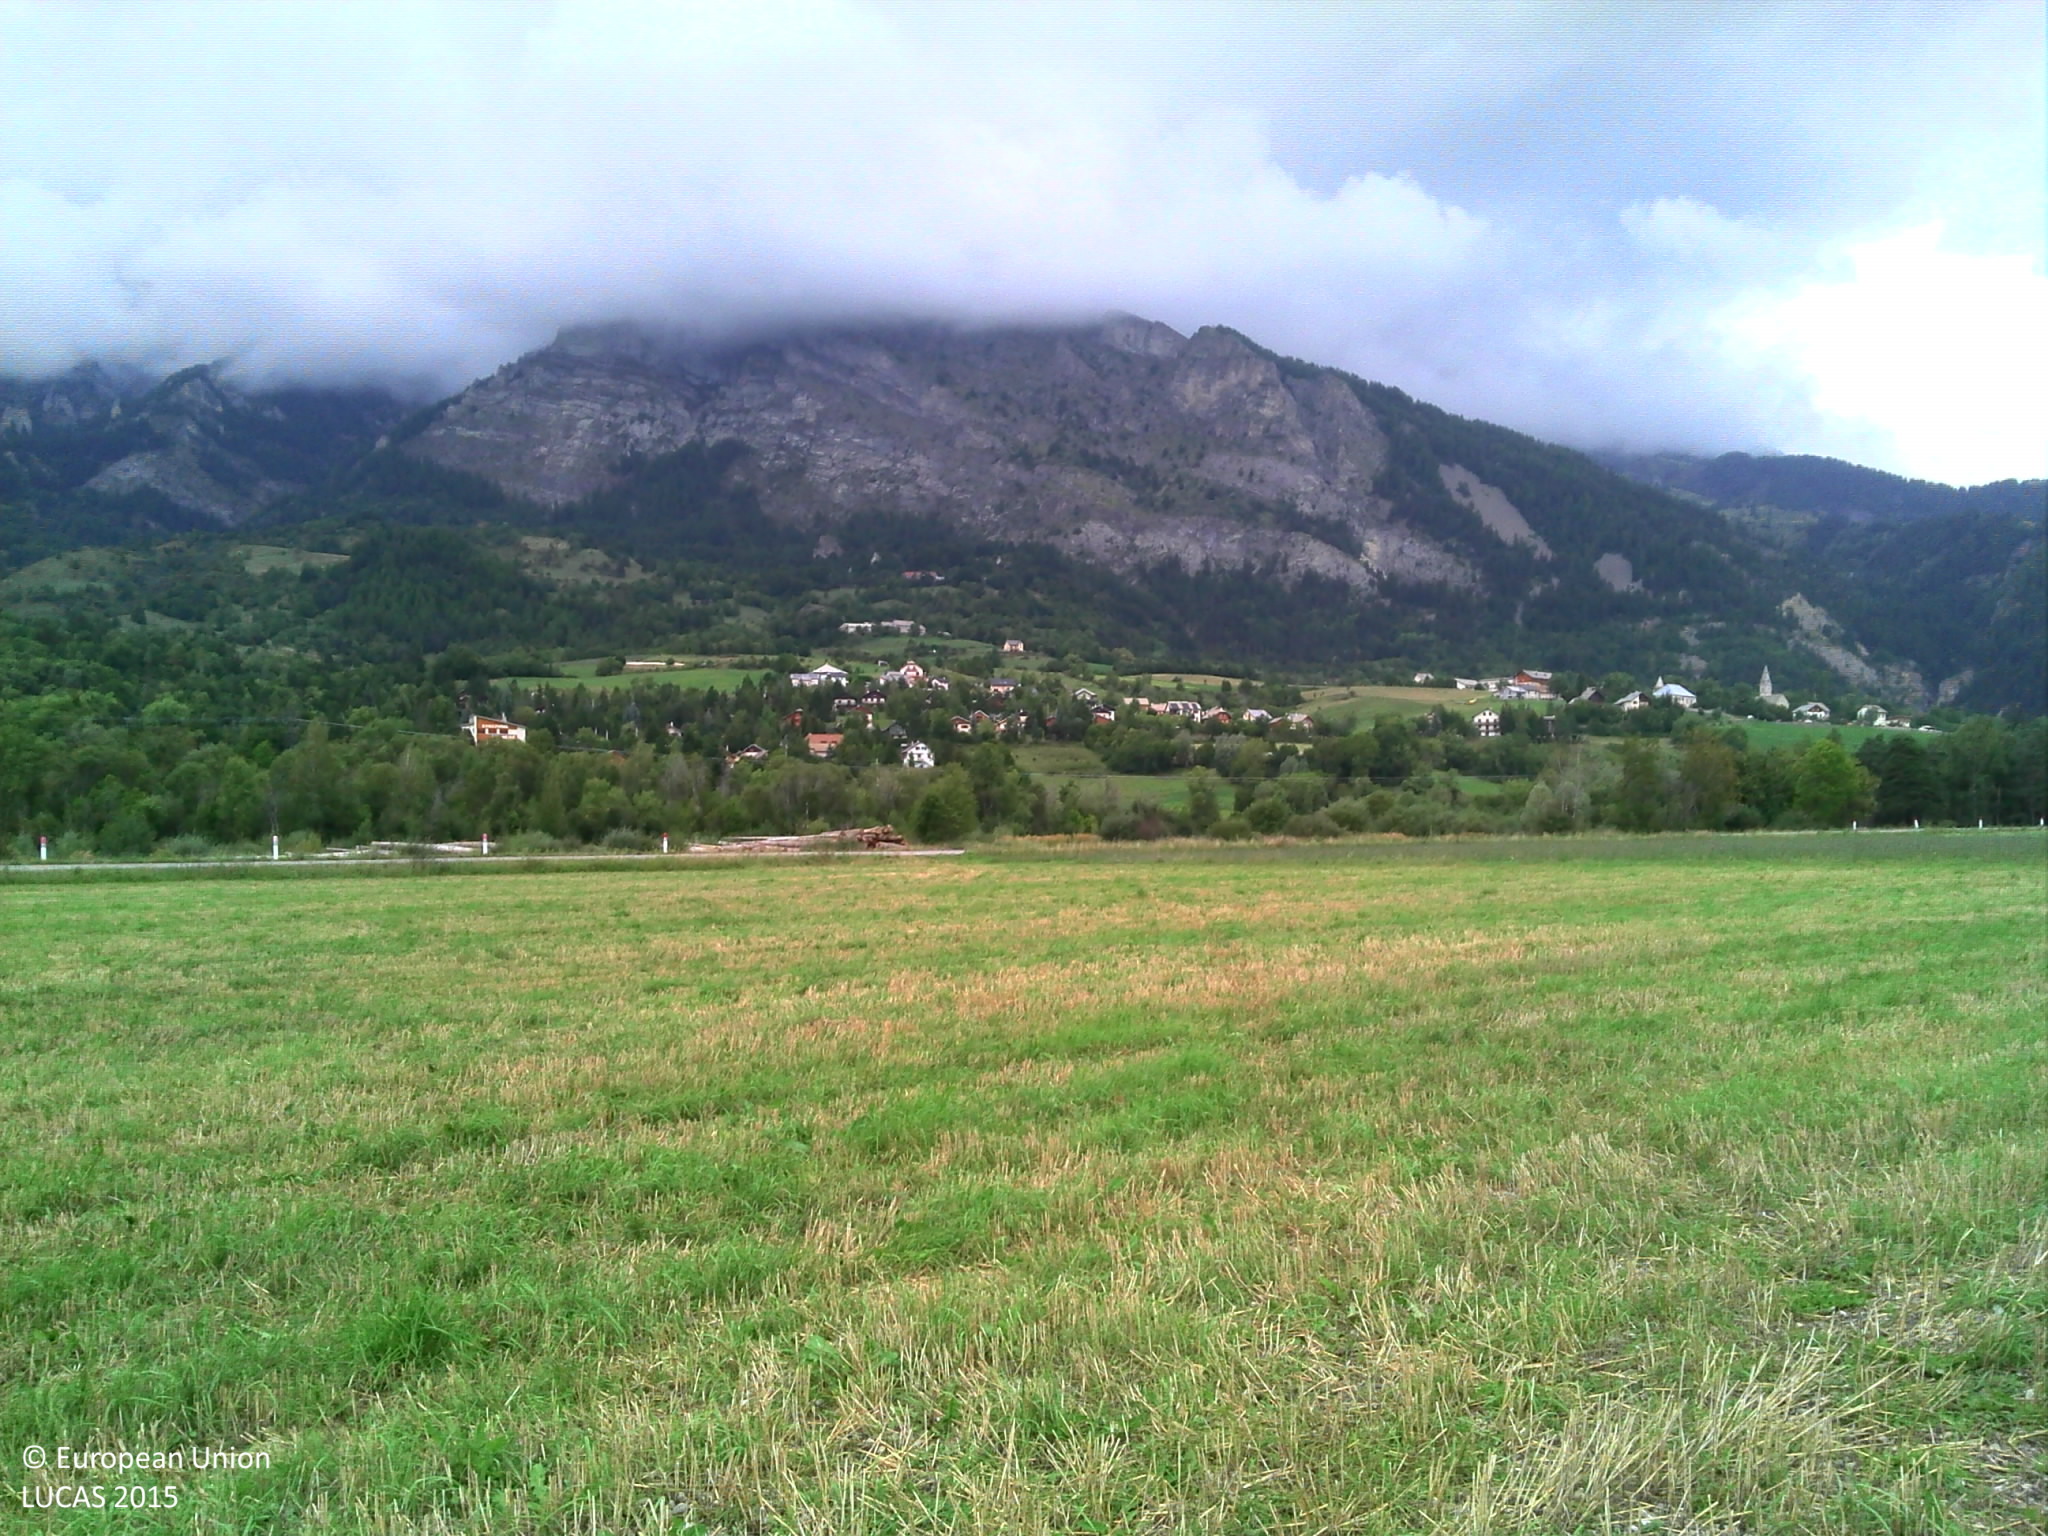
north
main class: Cropland
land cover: Common wheat
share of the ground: > 75 %
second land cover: Spontaneously vegetated surfaces
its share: > 75 %
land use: Agriculture (excluding fallow land and kitchen gardens)
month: September
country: FR
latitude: 44.6605
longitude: 6.2102
